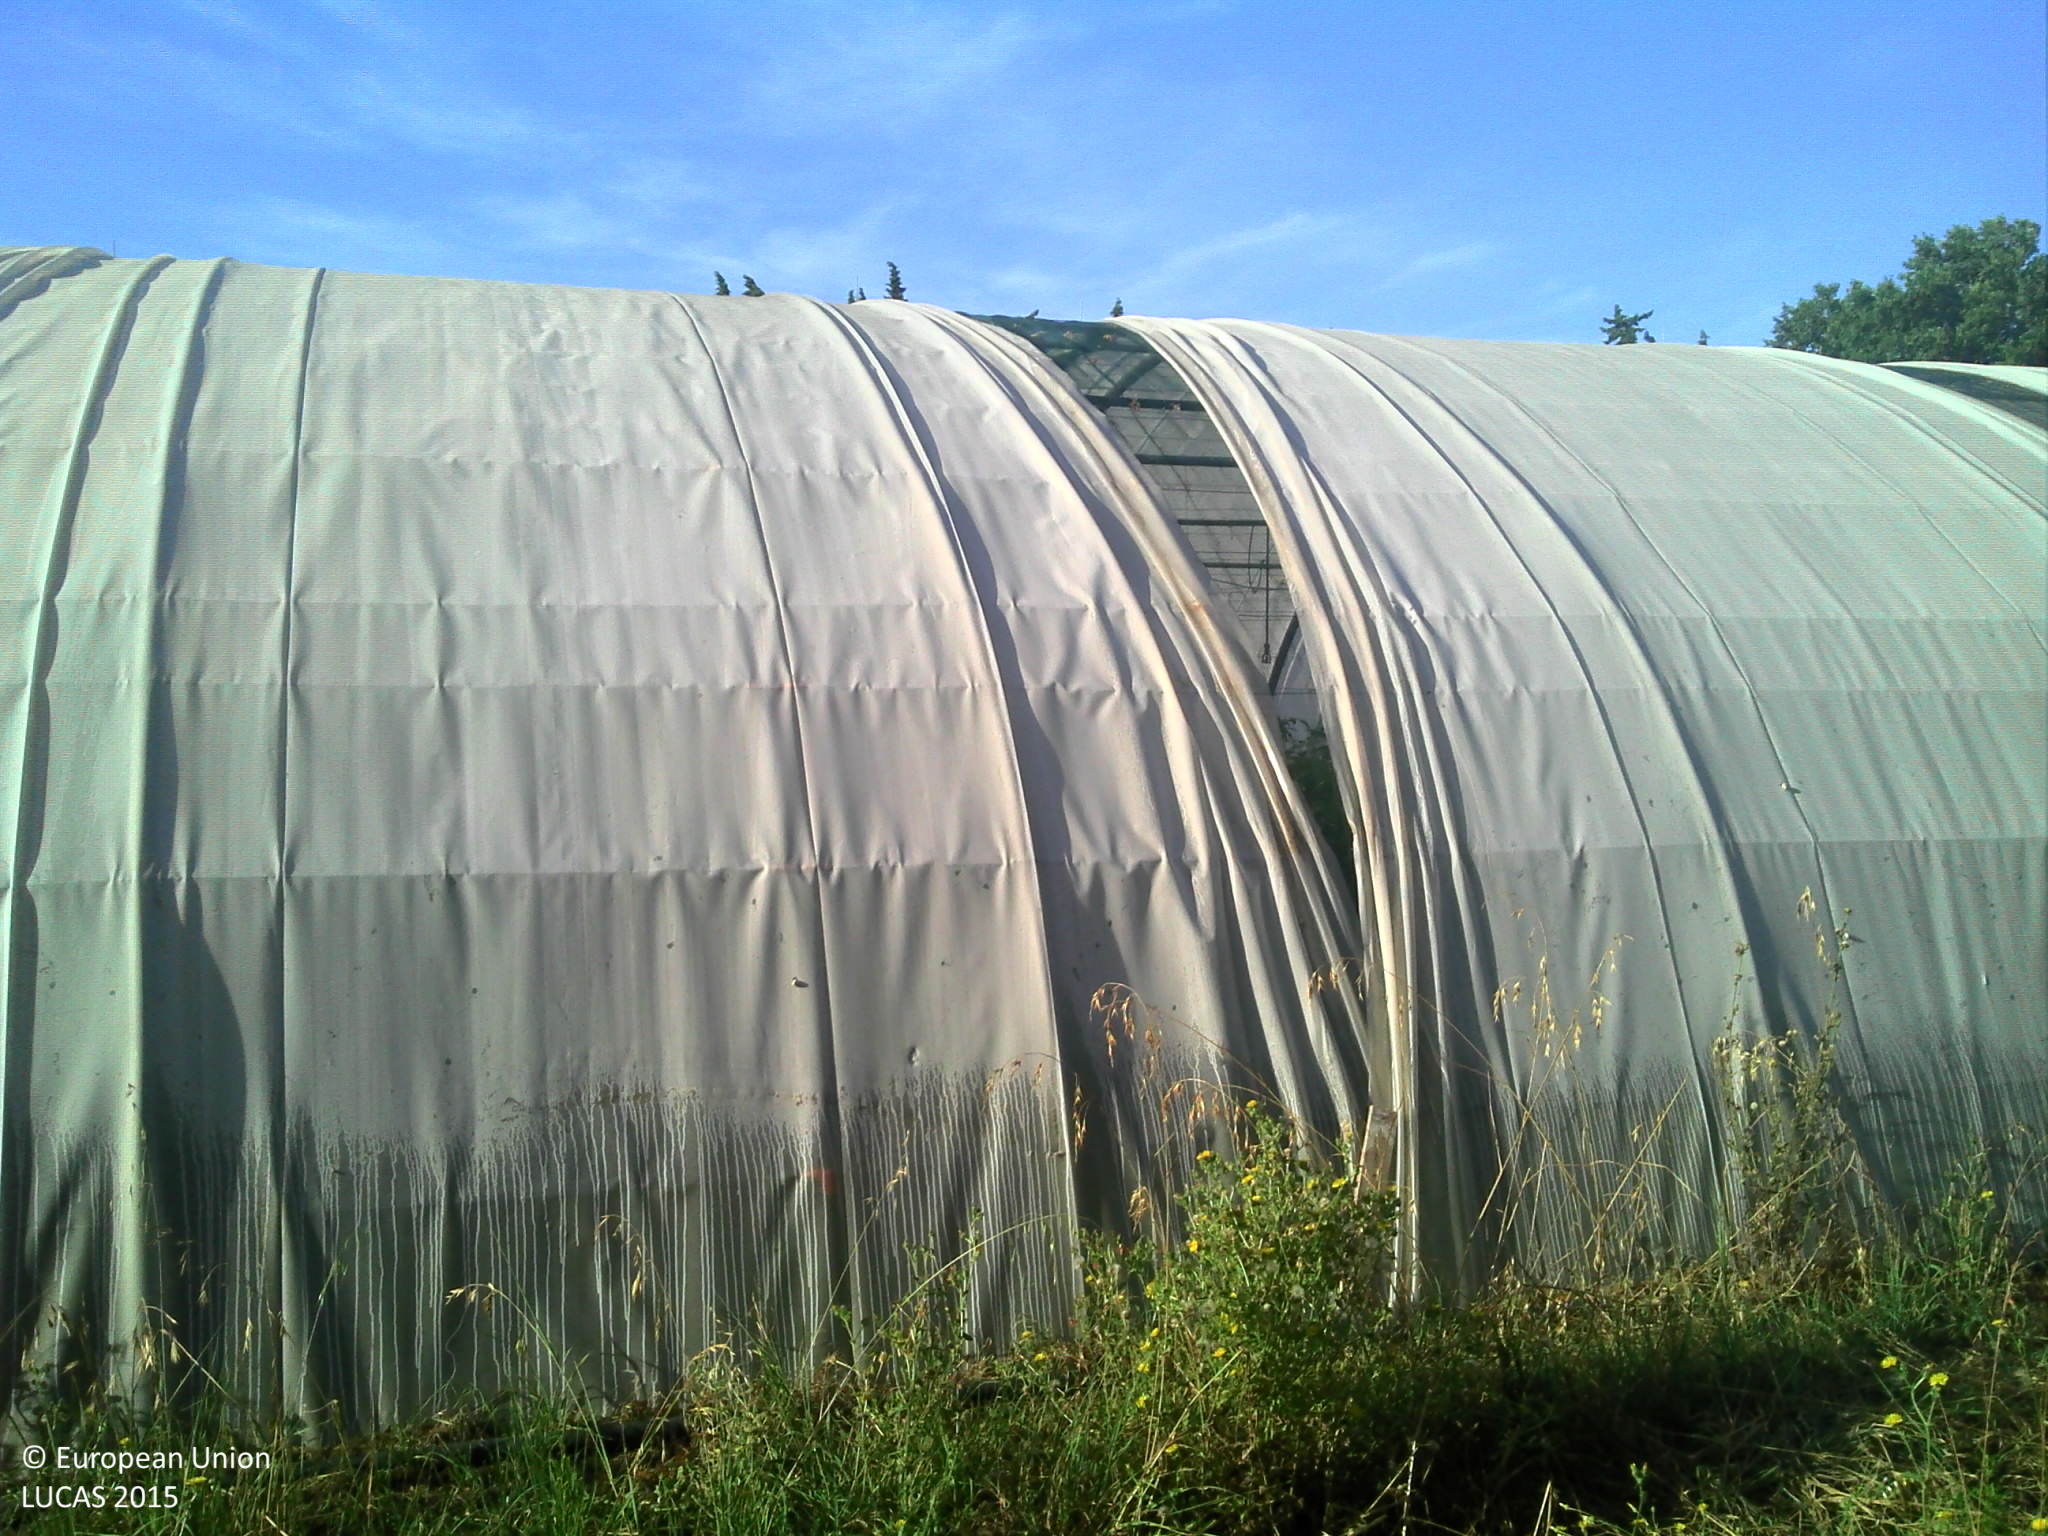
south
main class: Grassland
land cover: Spontaneously vegetated surfaces
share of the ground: > 75 %
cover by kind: herbaceous plants 100 %
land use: Agriculture (excluding fallow land and kitchen gardens)
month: July
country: FR
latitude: 43.8778
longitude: 4.8191
